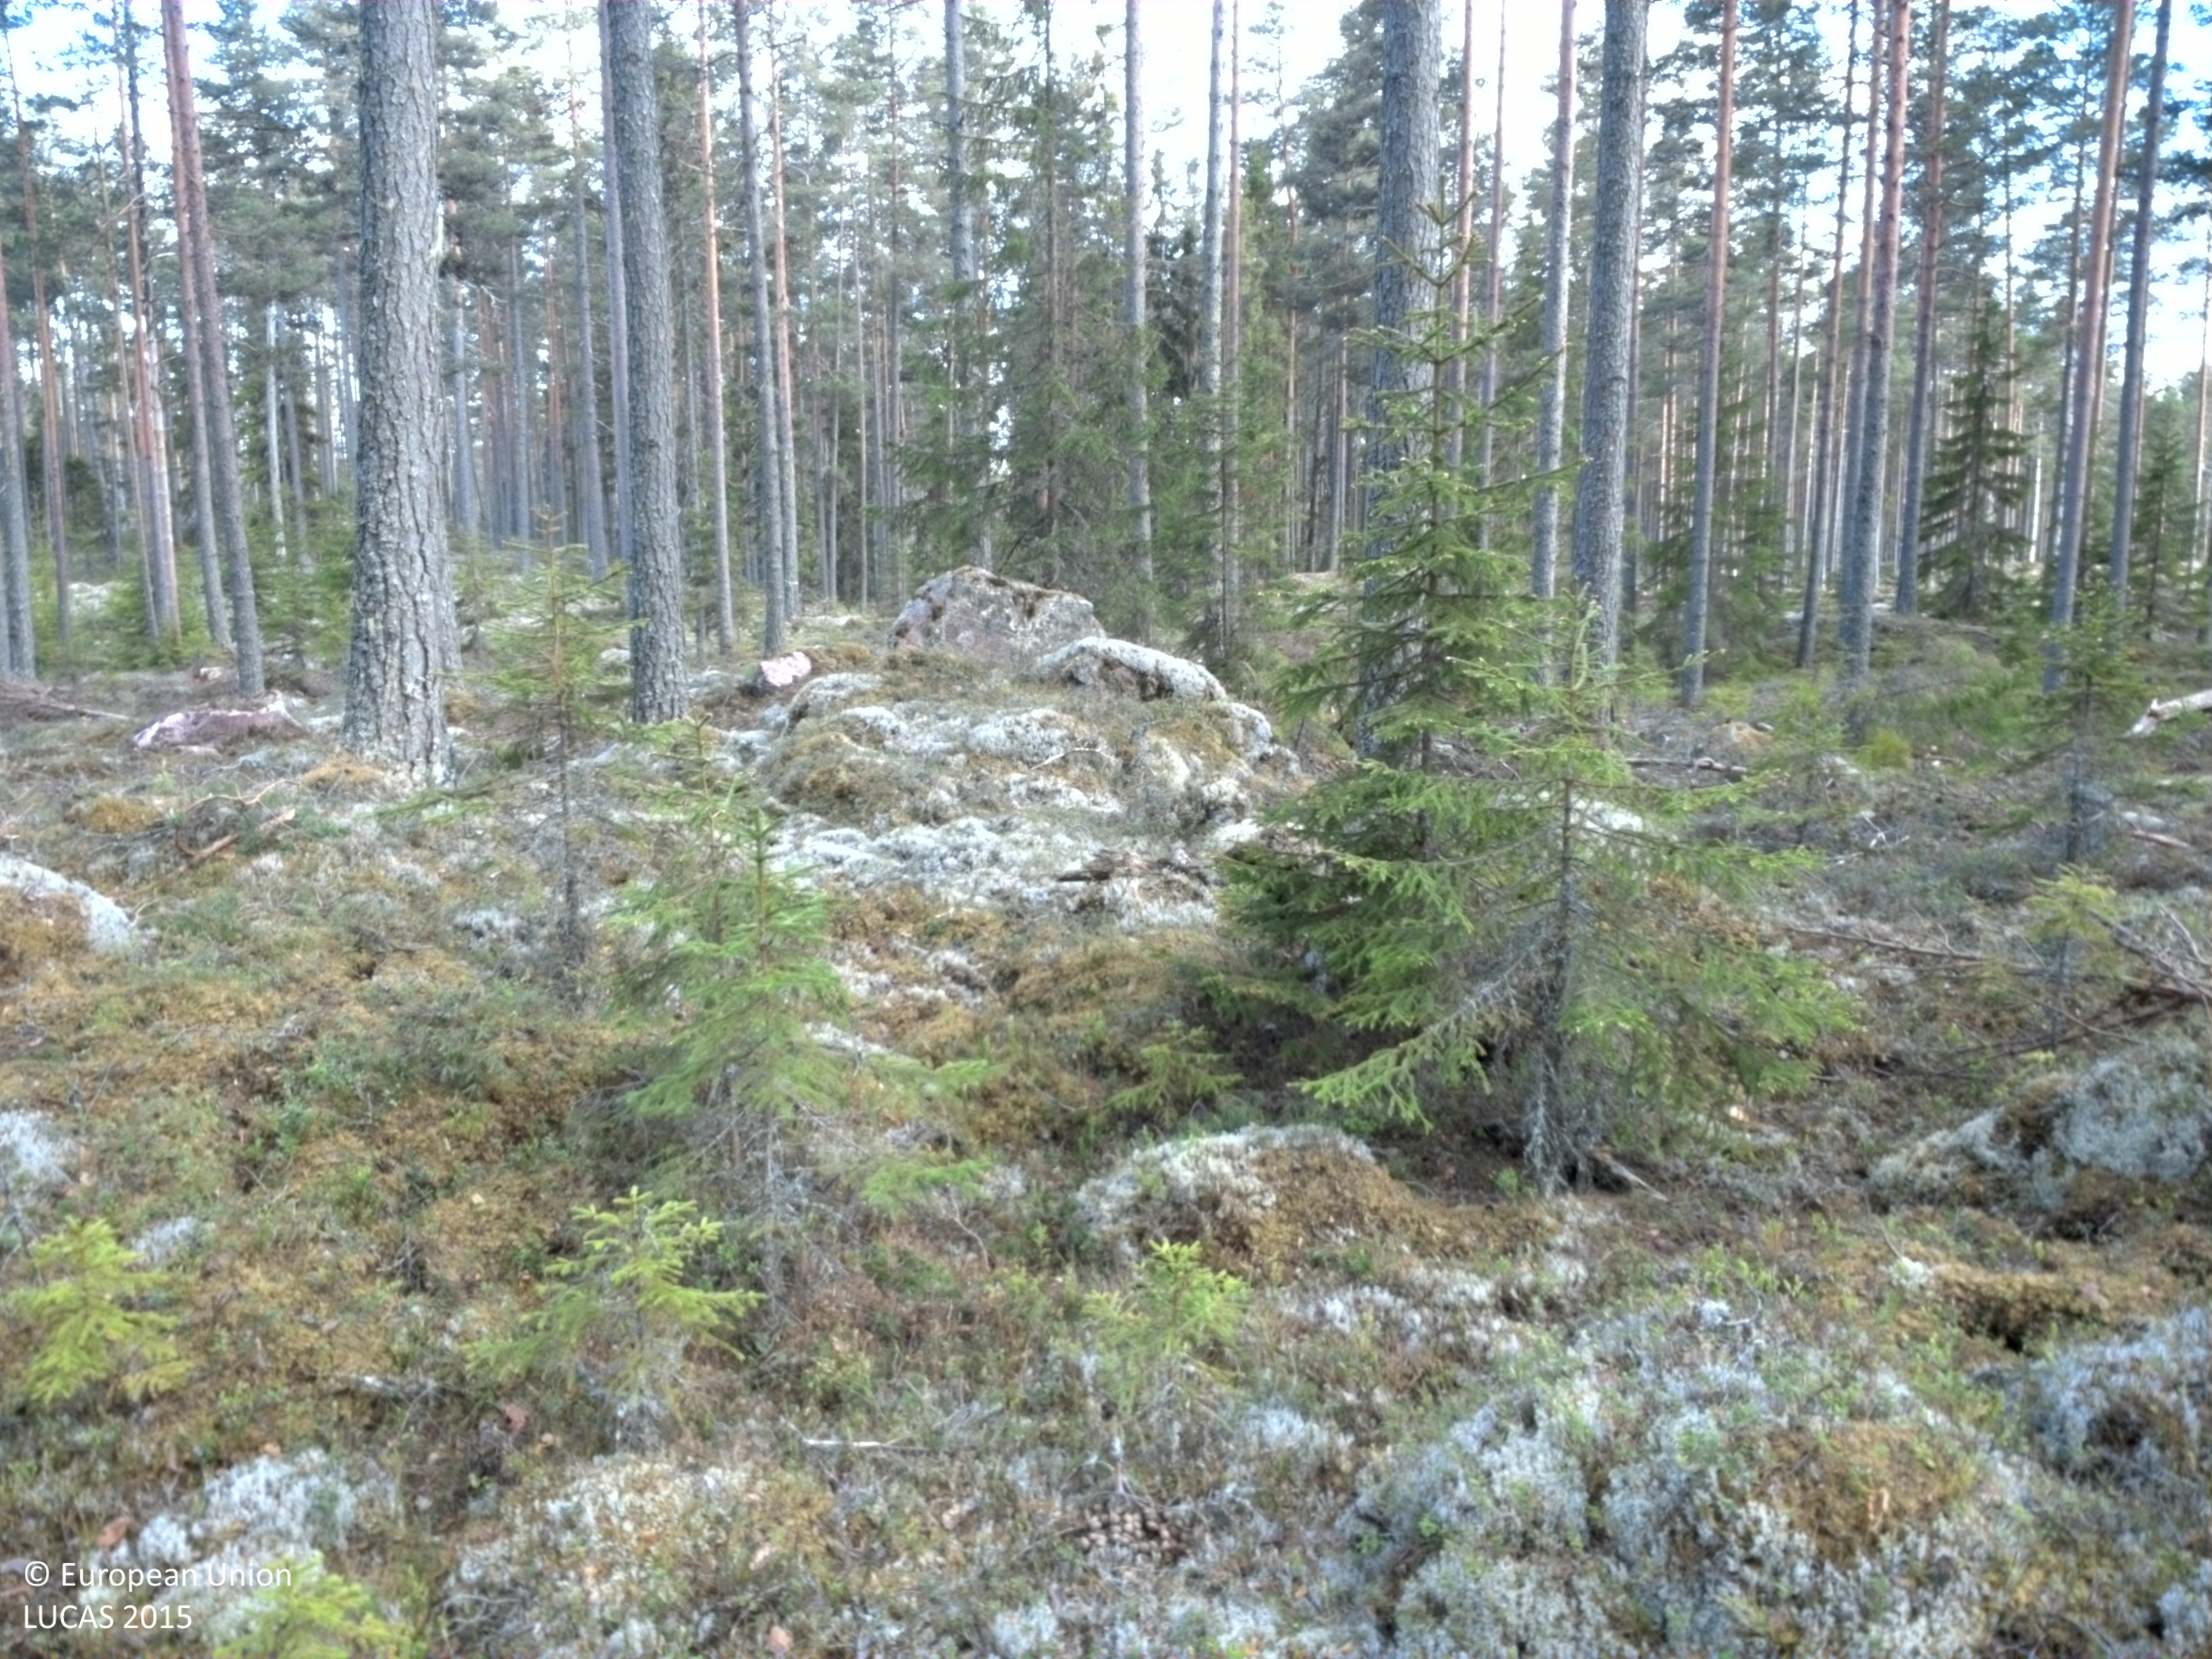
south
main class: Woodland
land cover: Pine dominated coniferous woodland
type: boreal forest
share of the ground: 25 - 50 %
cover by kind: coniferous forest trees 50 %, shrubs 25 %, lichens and mosses 25 %
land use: Forestry
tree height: > 5 m
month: June
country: SE
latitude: 60.4864
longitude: 13.2114
